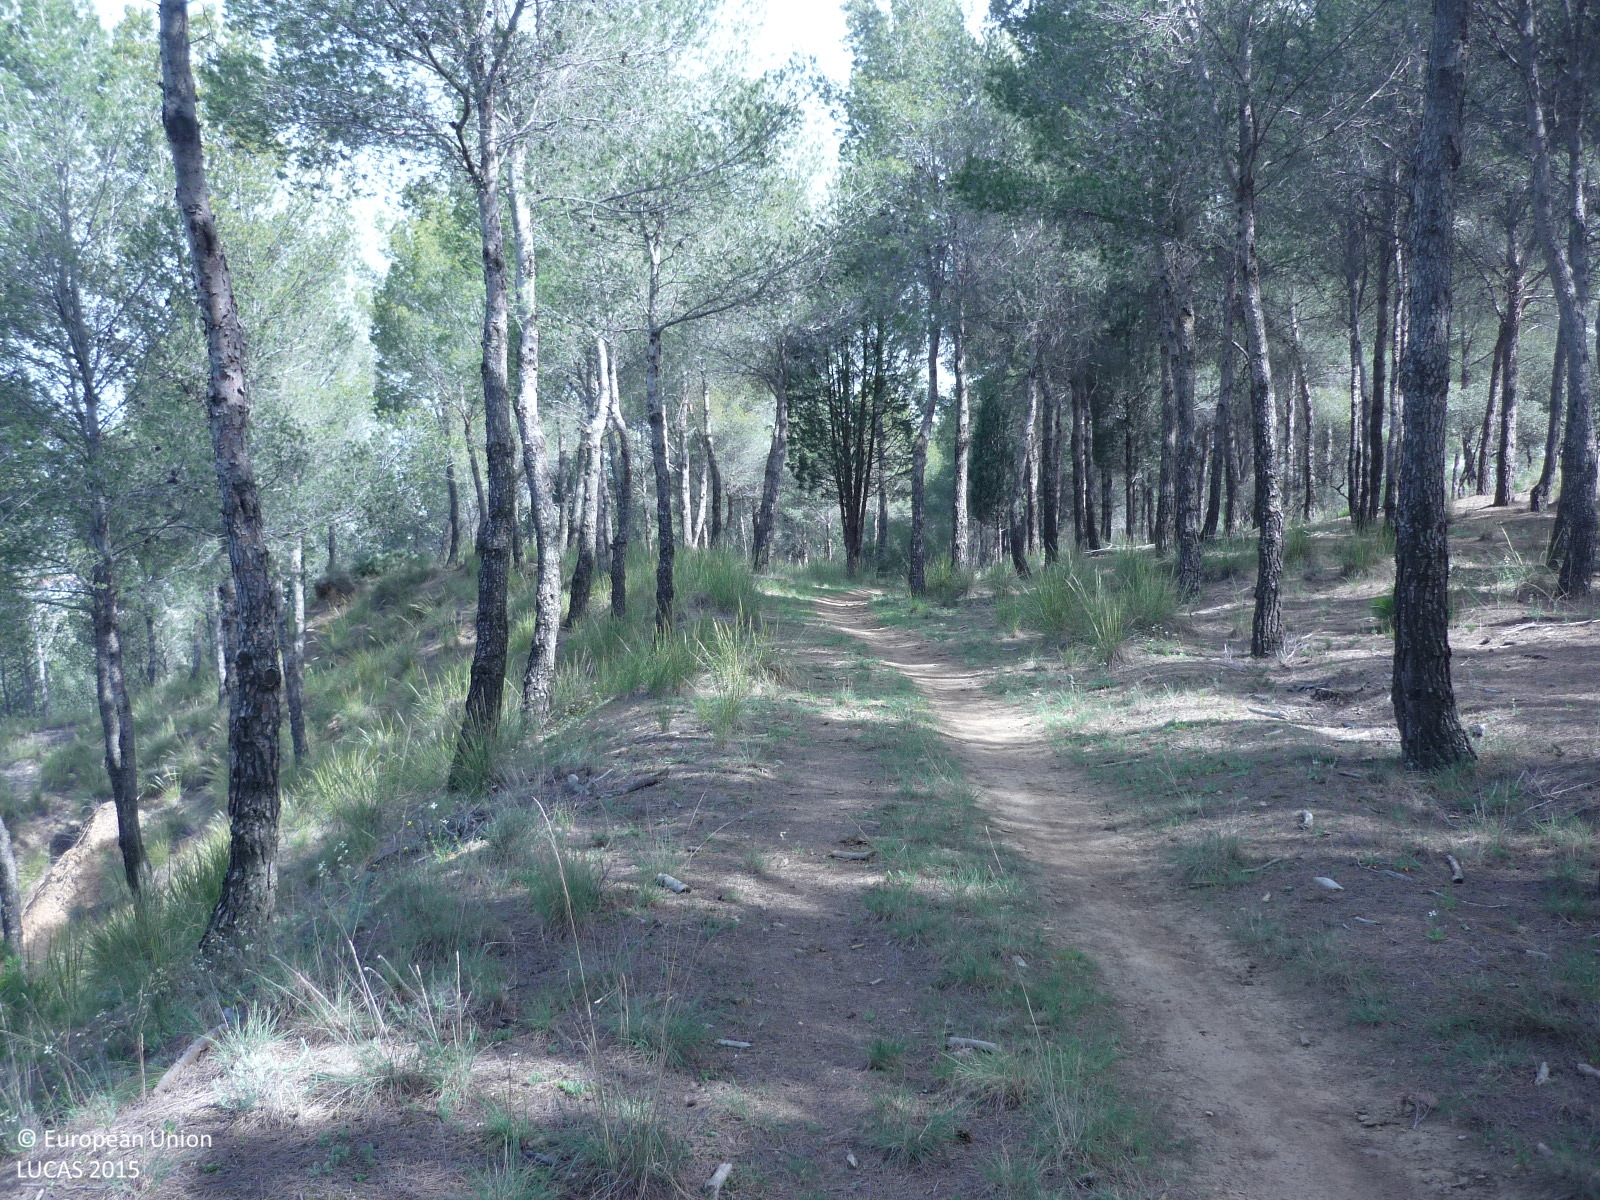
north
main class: Woodland
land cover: Pine dominated coniferous woodland
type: coniferous forest of the mediterranean region
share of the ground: > 75 %
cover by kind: coniferous forest trees 90 %, herbaceous plants 10 %
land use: Semi-natural and natural areas not in use
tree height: < 5 m
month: April
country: ES
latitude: 40.4610
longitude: -3.3955
